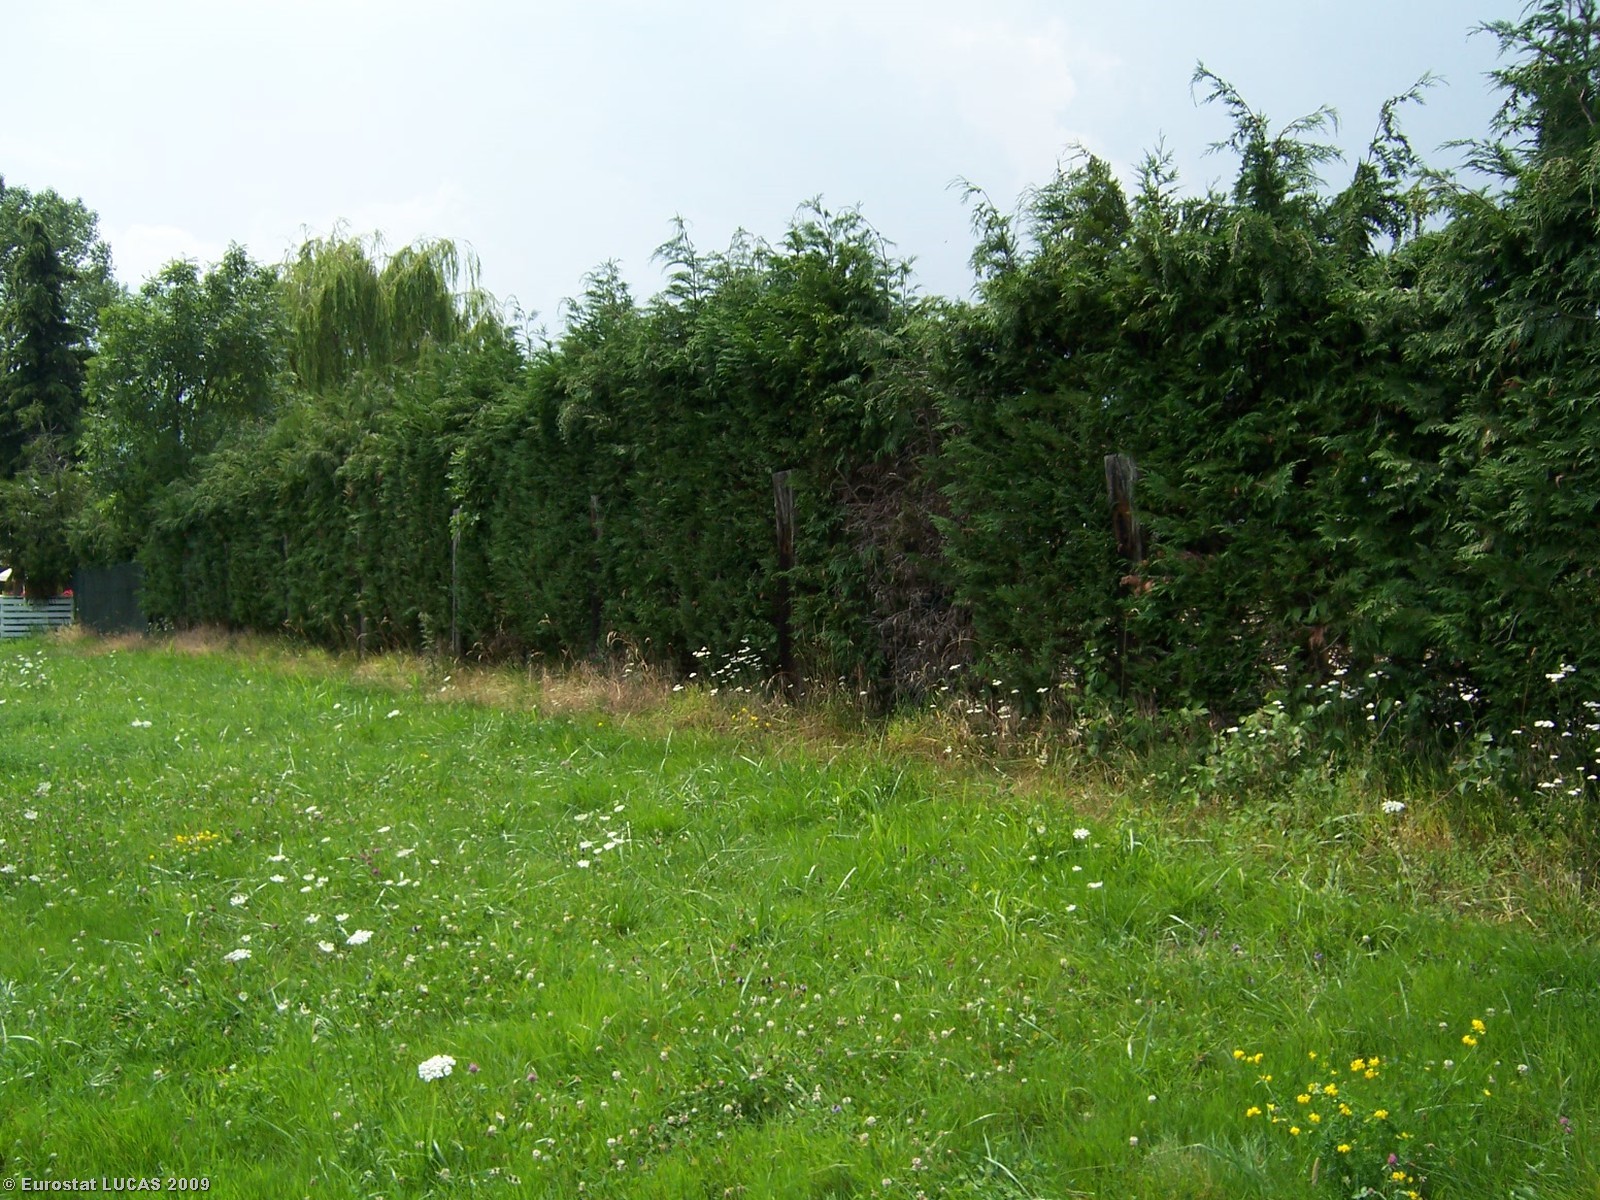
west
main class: Grassland
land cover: Grassland without tree/shrub cover
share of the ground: > 75 %
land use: Agriculture (excluding fallow land and kitchen gardens)
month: July
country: IT
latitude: 45.0558
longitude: 7.3252
